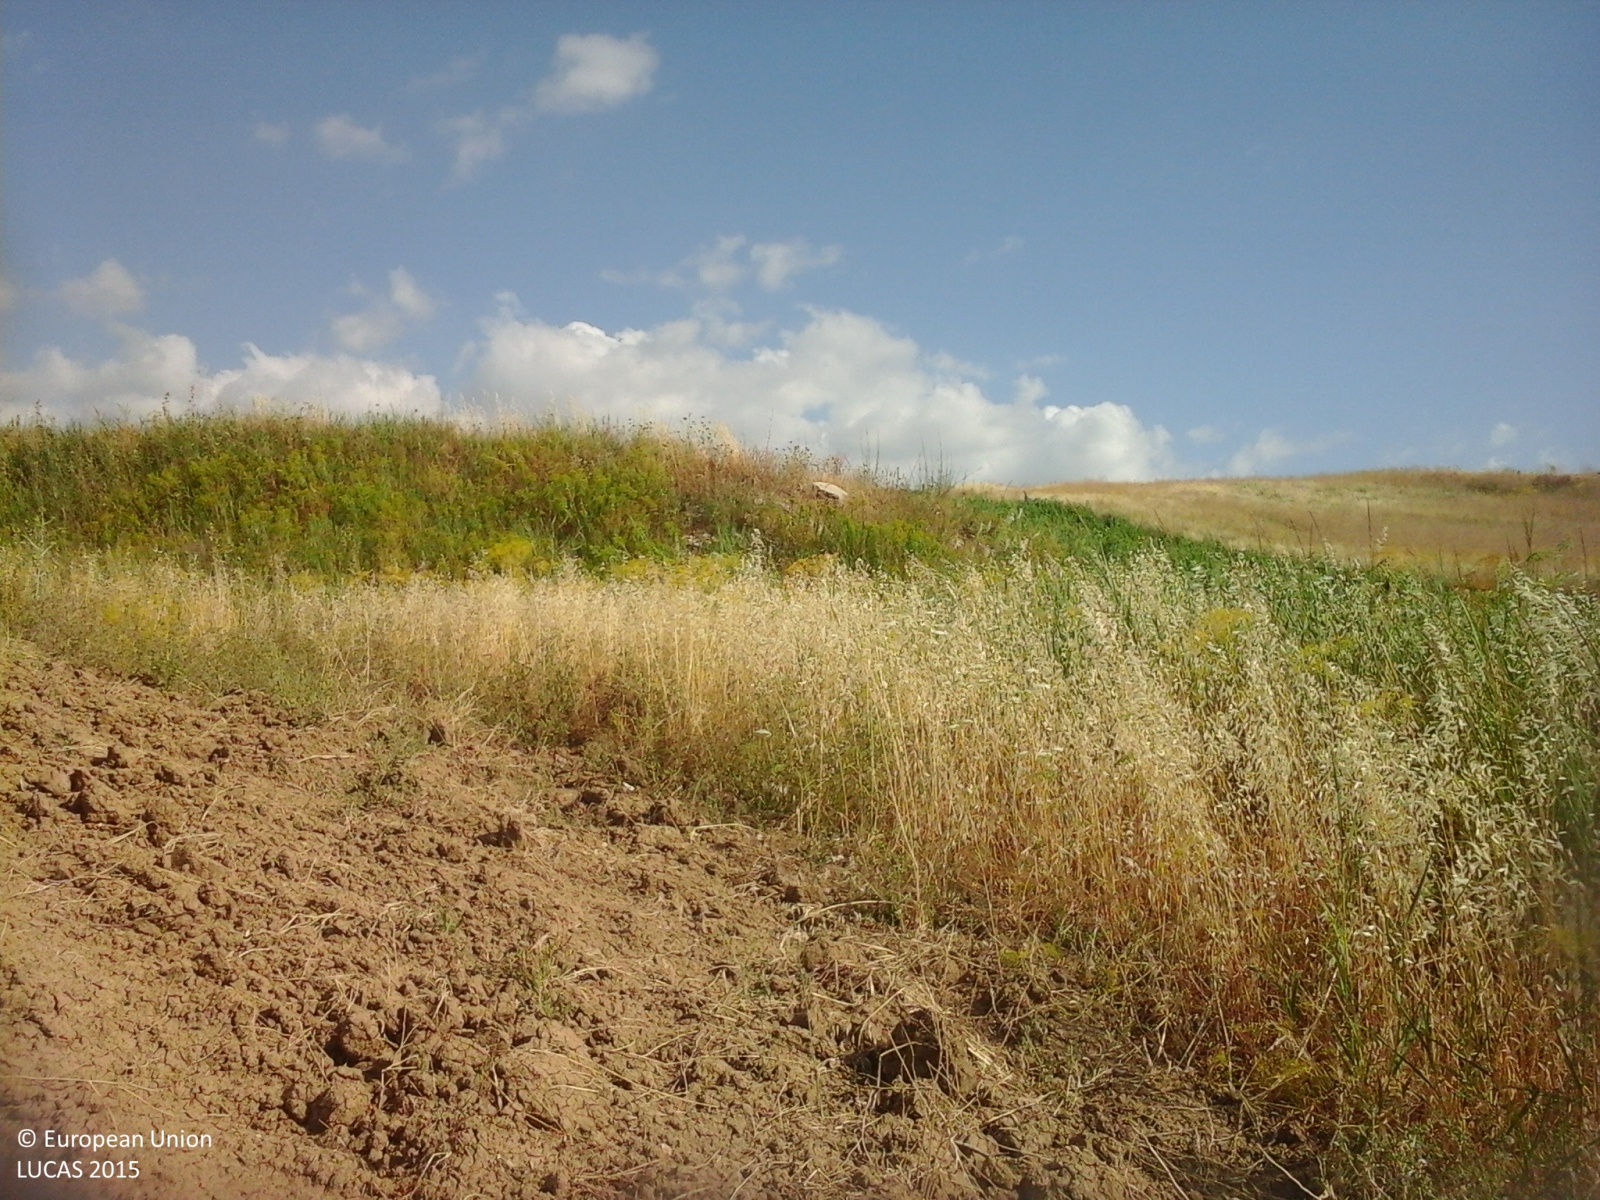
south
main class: Grassland
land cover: Spontaneously vegetated surfaces
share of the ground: > 75 %
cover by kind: herbaceous plants 100 %
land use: Fallow land
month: June
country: IT
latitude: 37.7342
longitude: 13.0748
